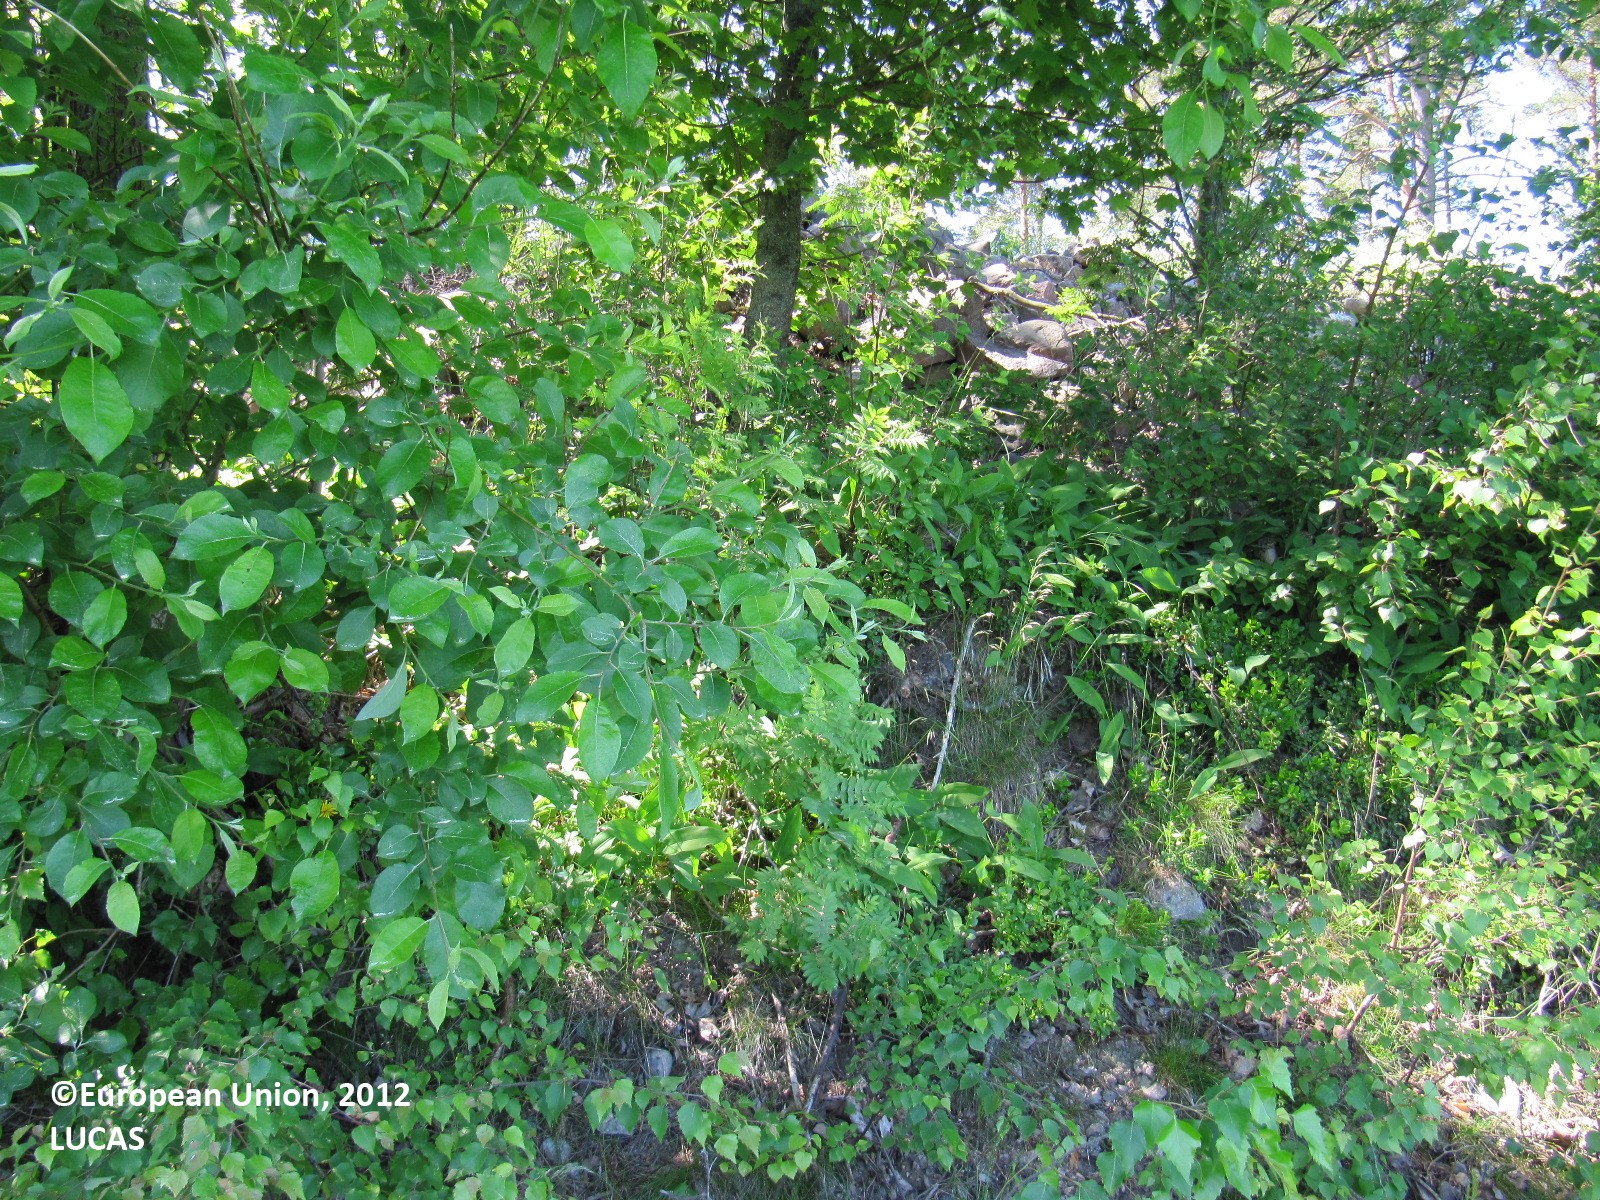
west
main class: Cropland
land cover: Barley
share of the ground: > 75 %
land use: Agriculture (excluding fallow land and kitchen gardens)
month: June
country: FI
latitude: 60.0065
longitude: 23.0846
